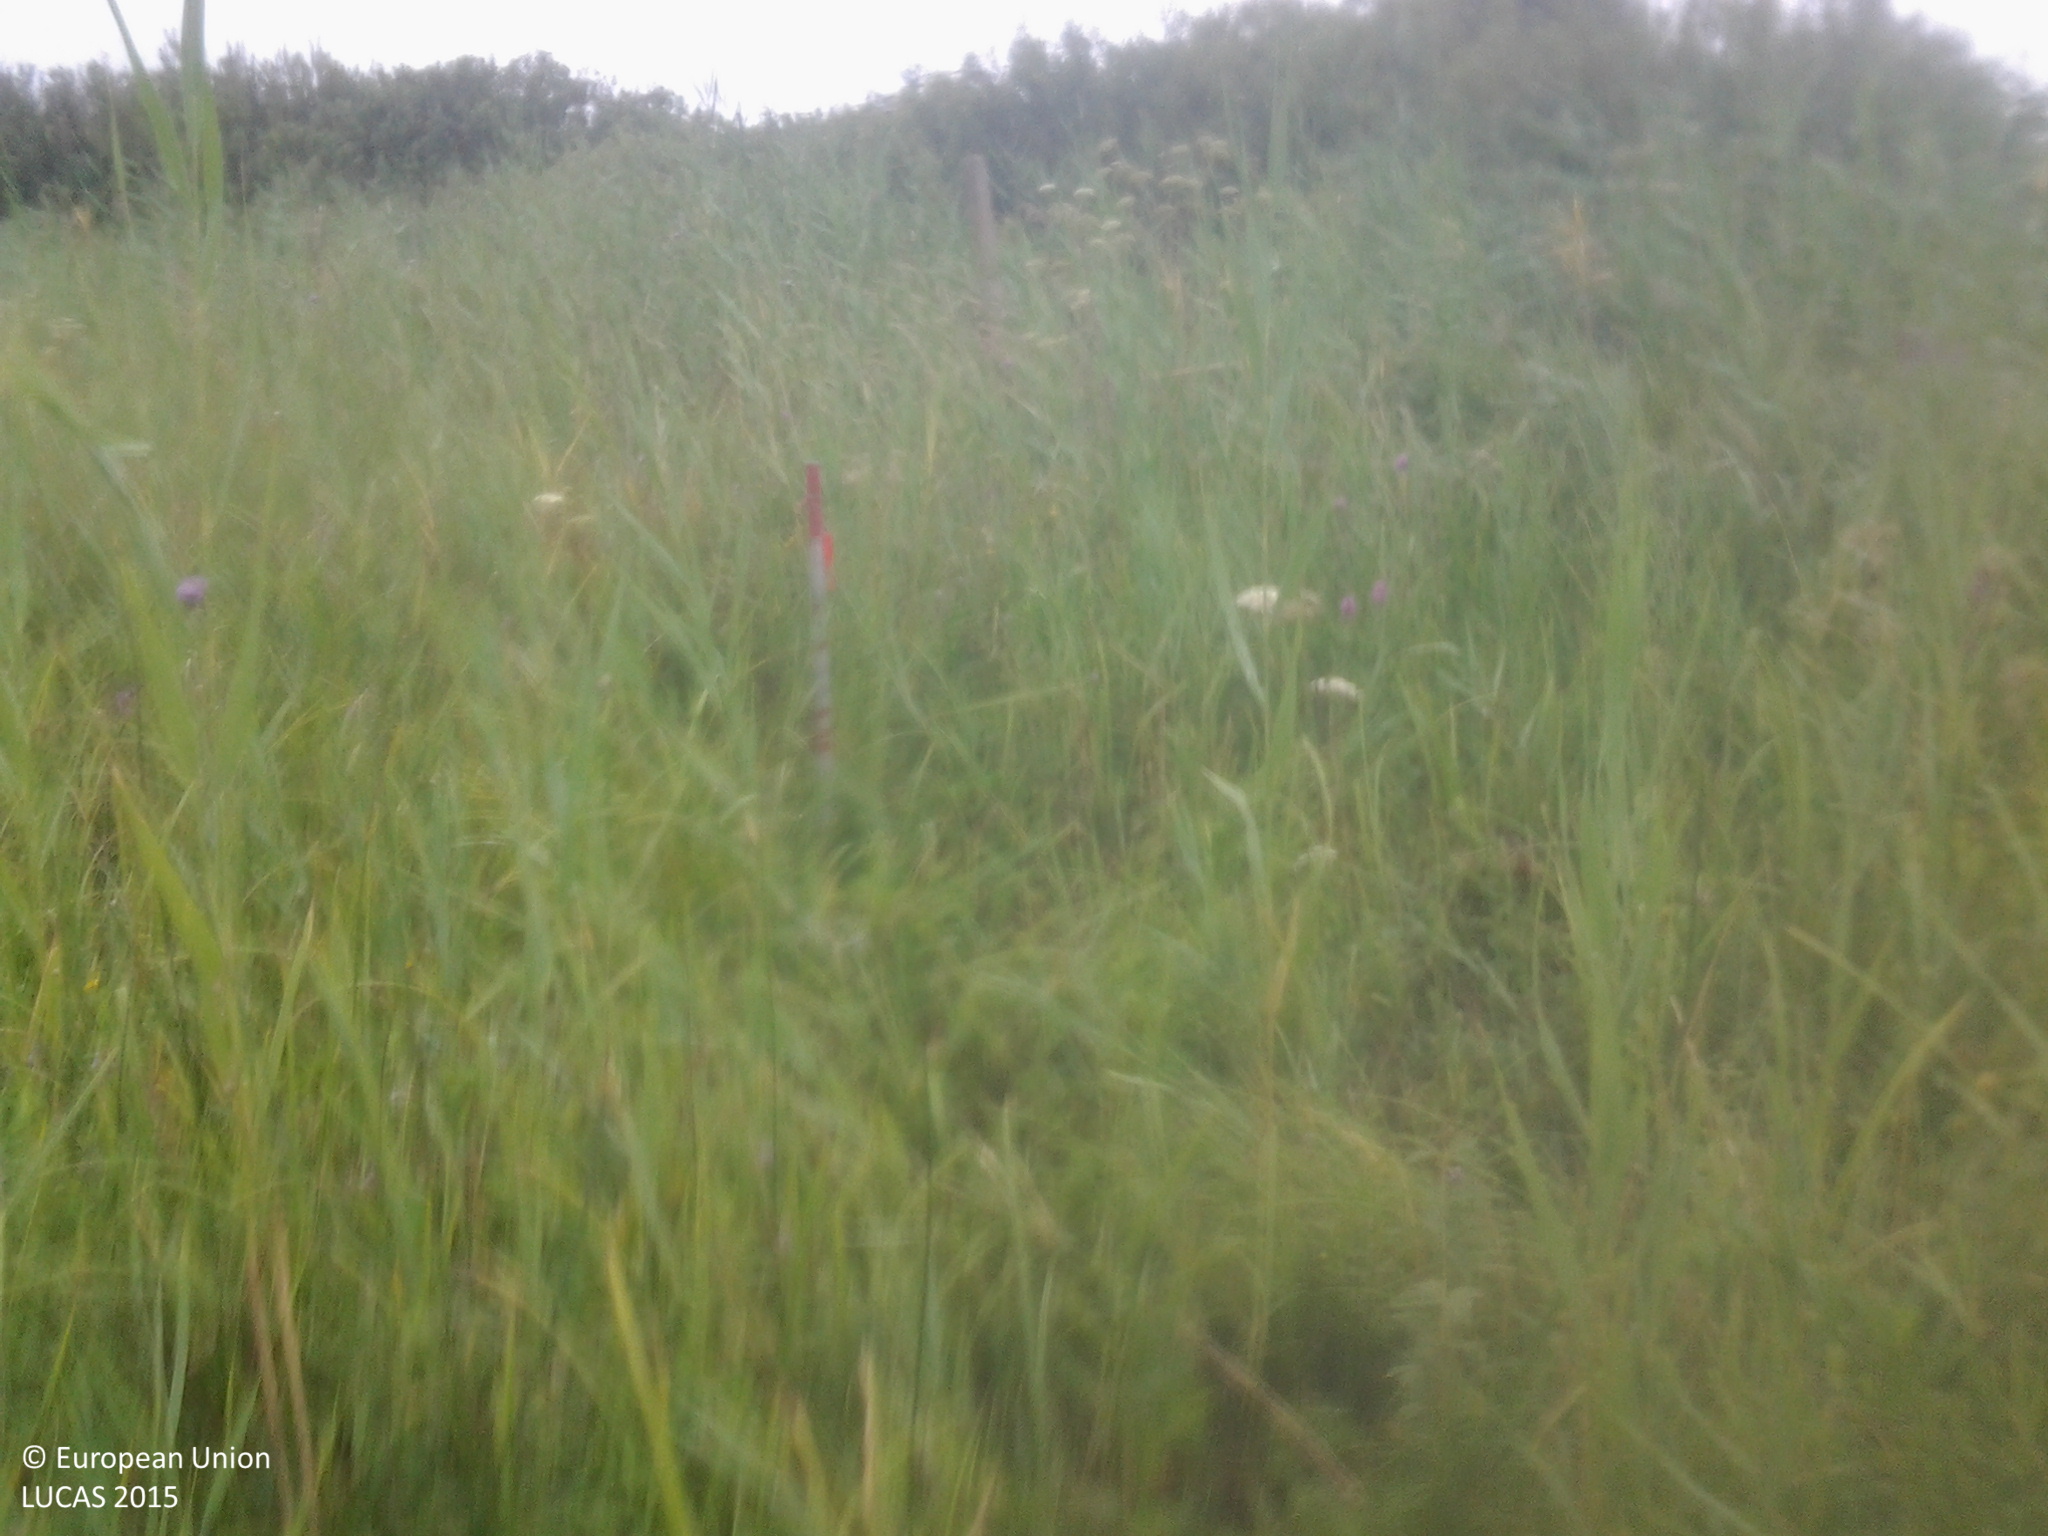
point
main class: Grassland
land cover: Grassland without tree/shrub cover
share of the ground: > 75 %
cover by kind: herbaceous plants 100 %
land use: Agriculture (excluding fallow land and kitchen gardens)
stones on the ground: < 10 %
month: July
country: HU
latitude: 46.6426
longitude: 19.2000
